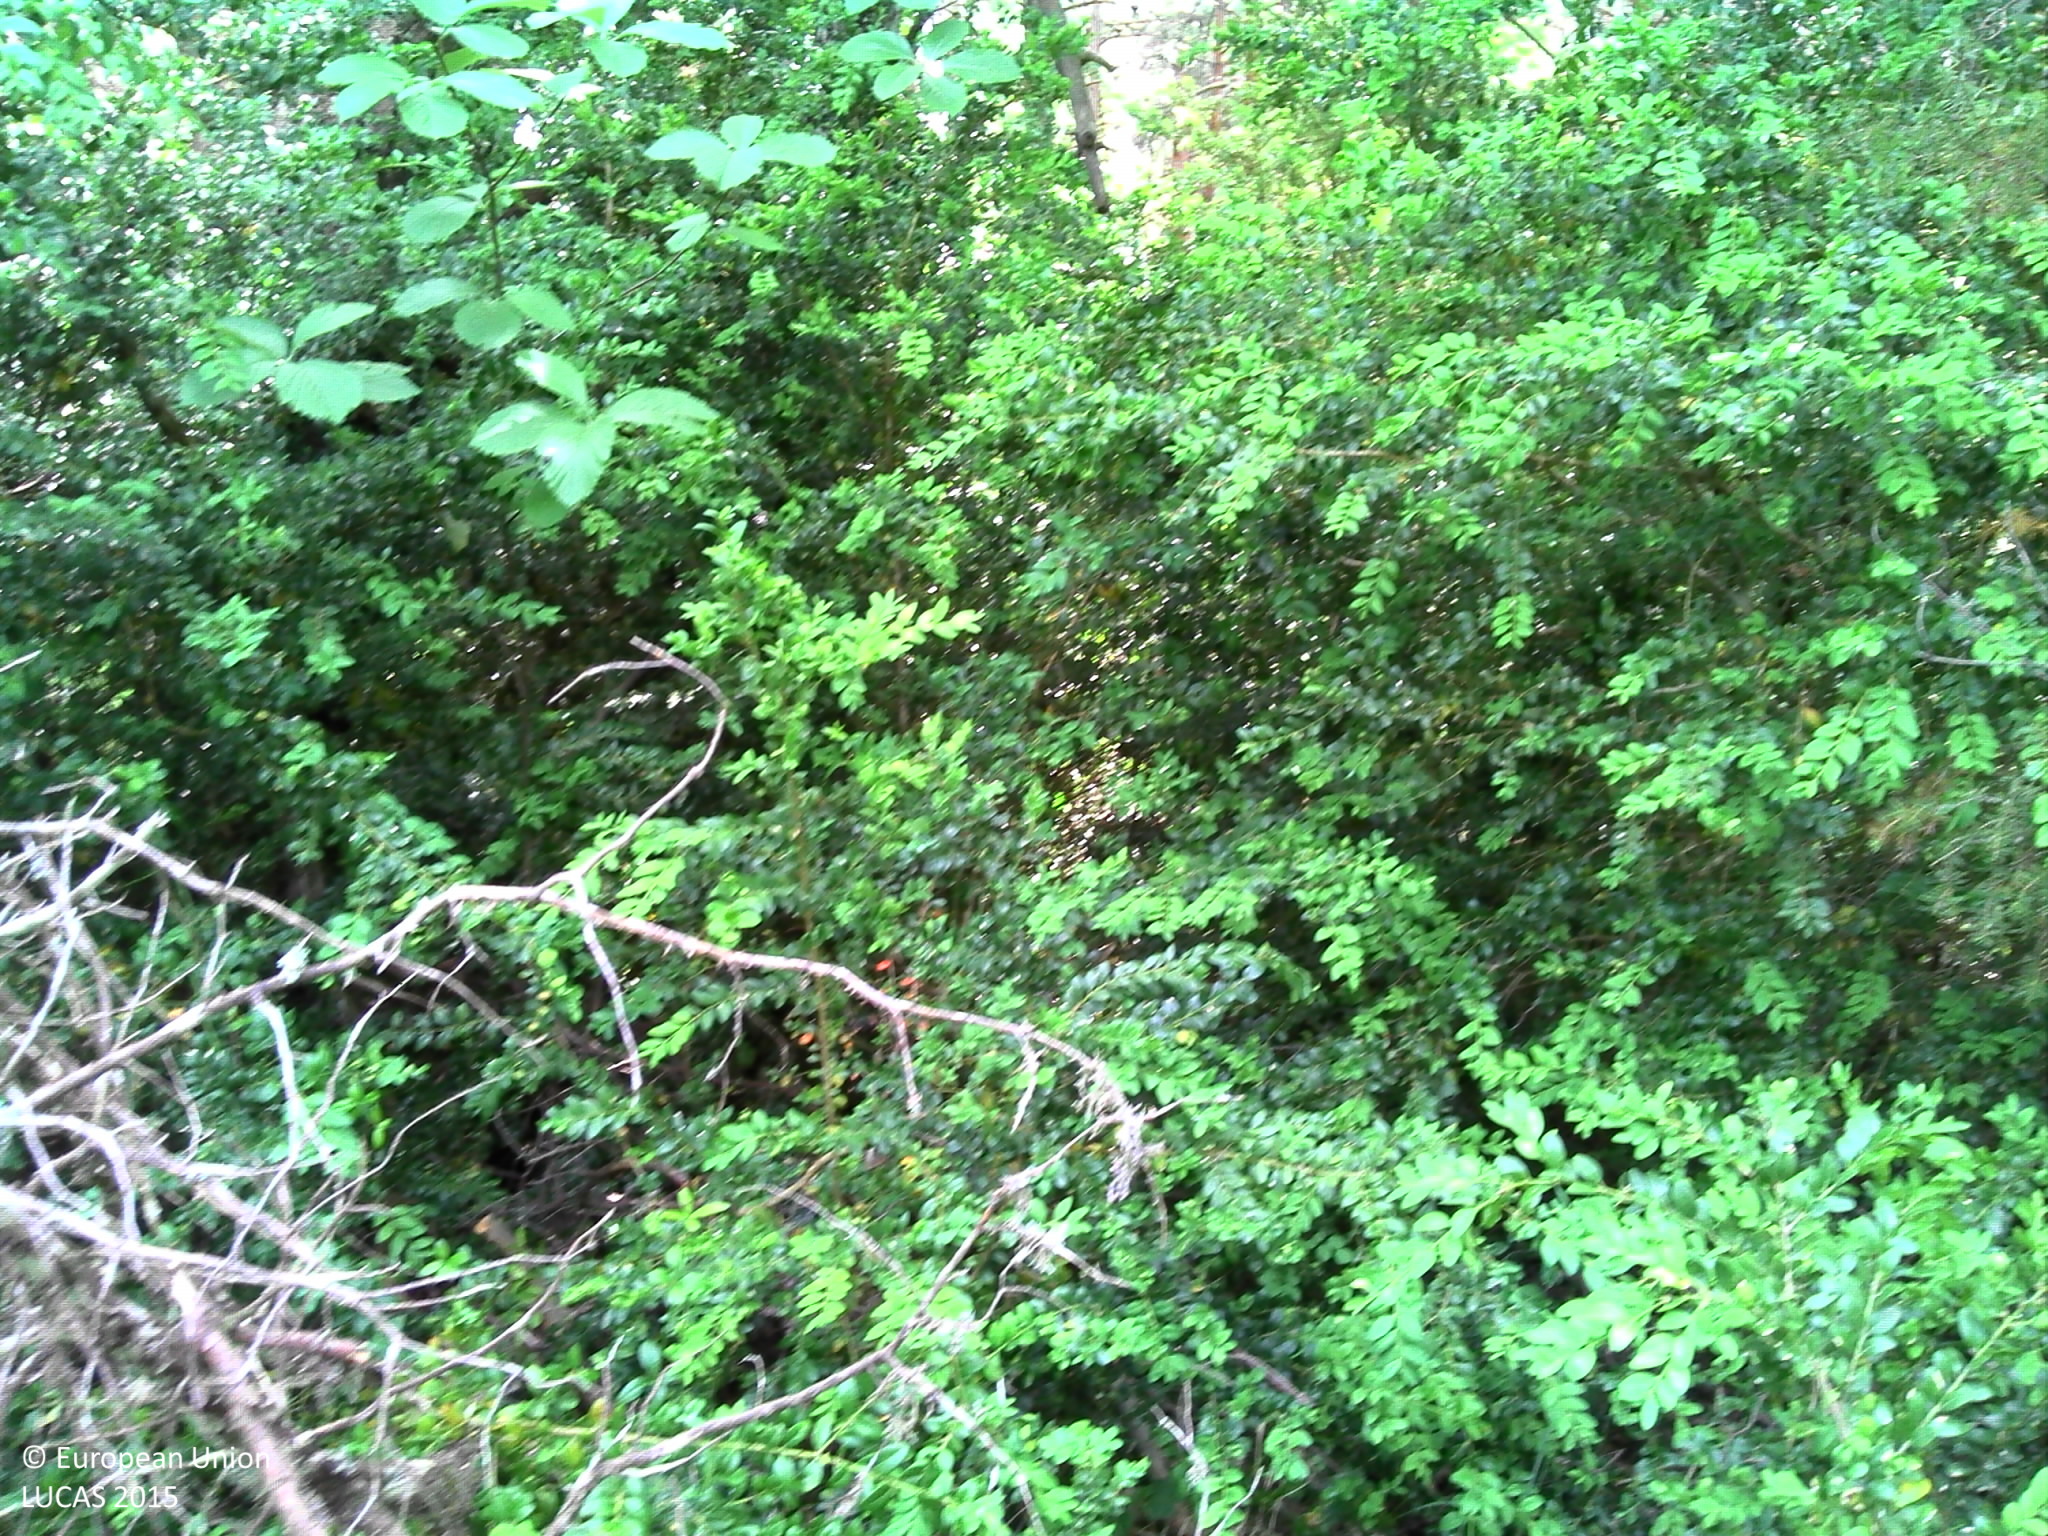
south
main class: Woodland
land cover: Pine dominated mixed woodland
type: mountainous beech forest
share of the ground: > 75 %
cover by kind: coniferous forest trees 35 %, broadleaved forest trees 35 %, herbaceous plants 20 %, lichens and mosses 10 %
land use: Forestry
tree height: > 5 m
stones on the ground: 25 - 50 %
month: June
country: FR
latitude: 44.1483
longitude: 3.2425
